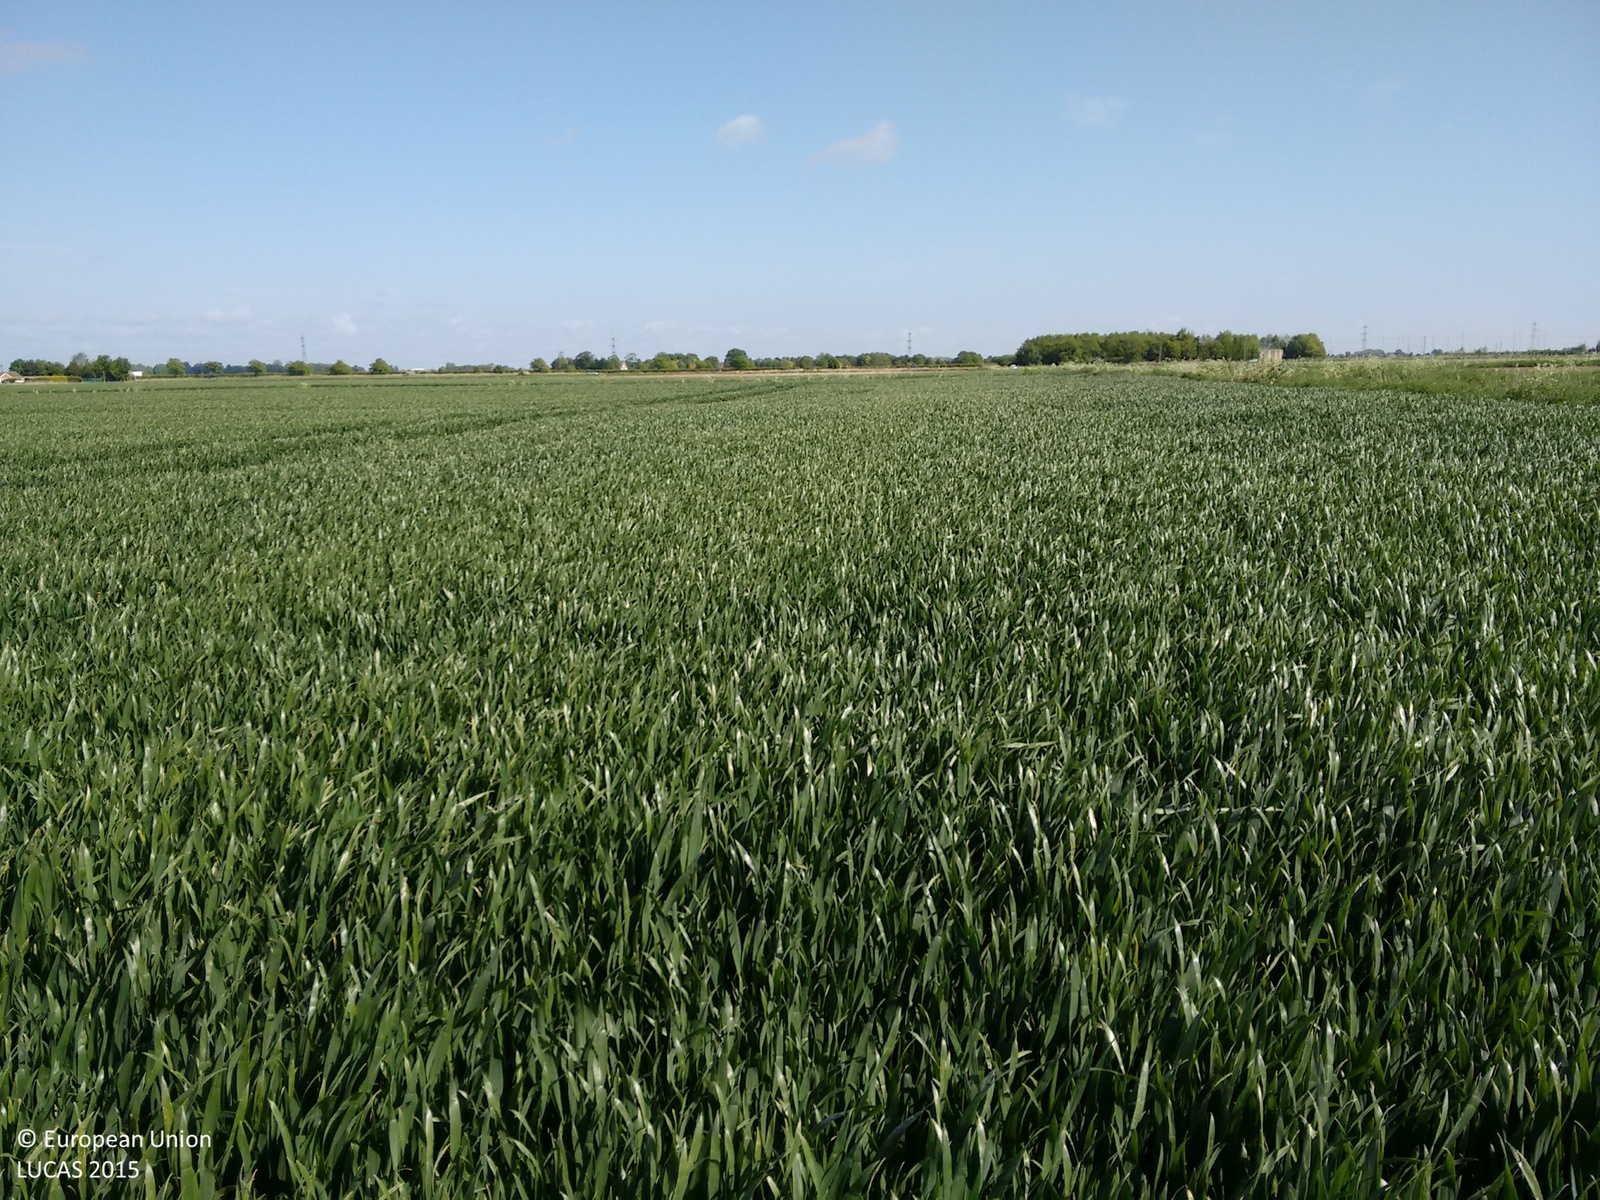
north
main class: Cropland
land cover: Common wheat
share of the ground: > 75 %
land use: Agriculture (excluding fallow land and kitchen gardens)
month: May
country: GB
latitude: 52.7971
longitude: -0.1037
